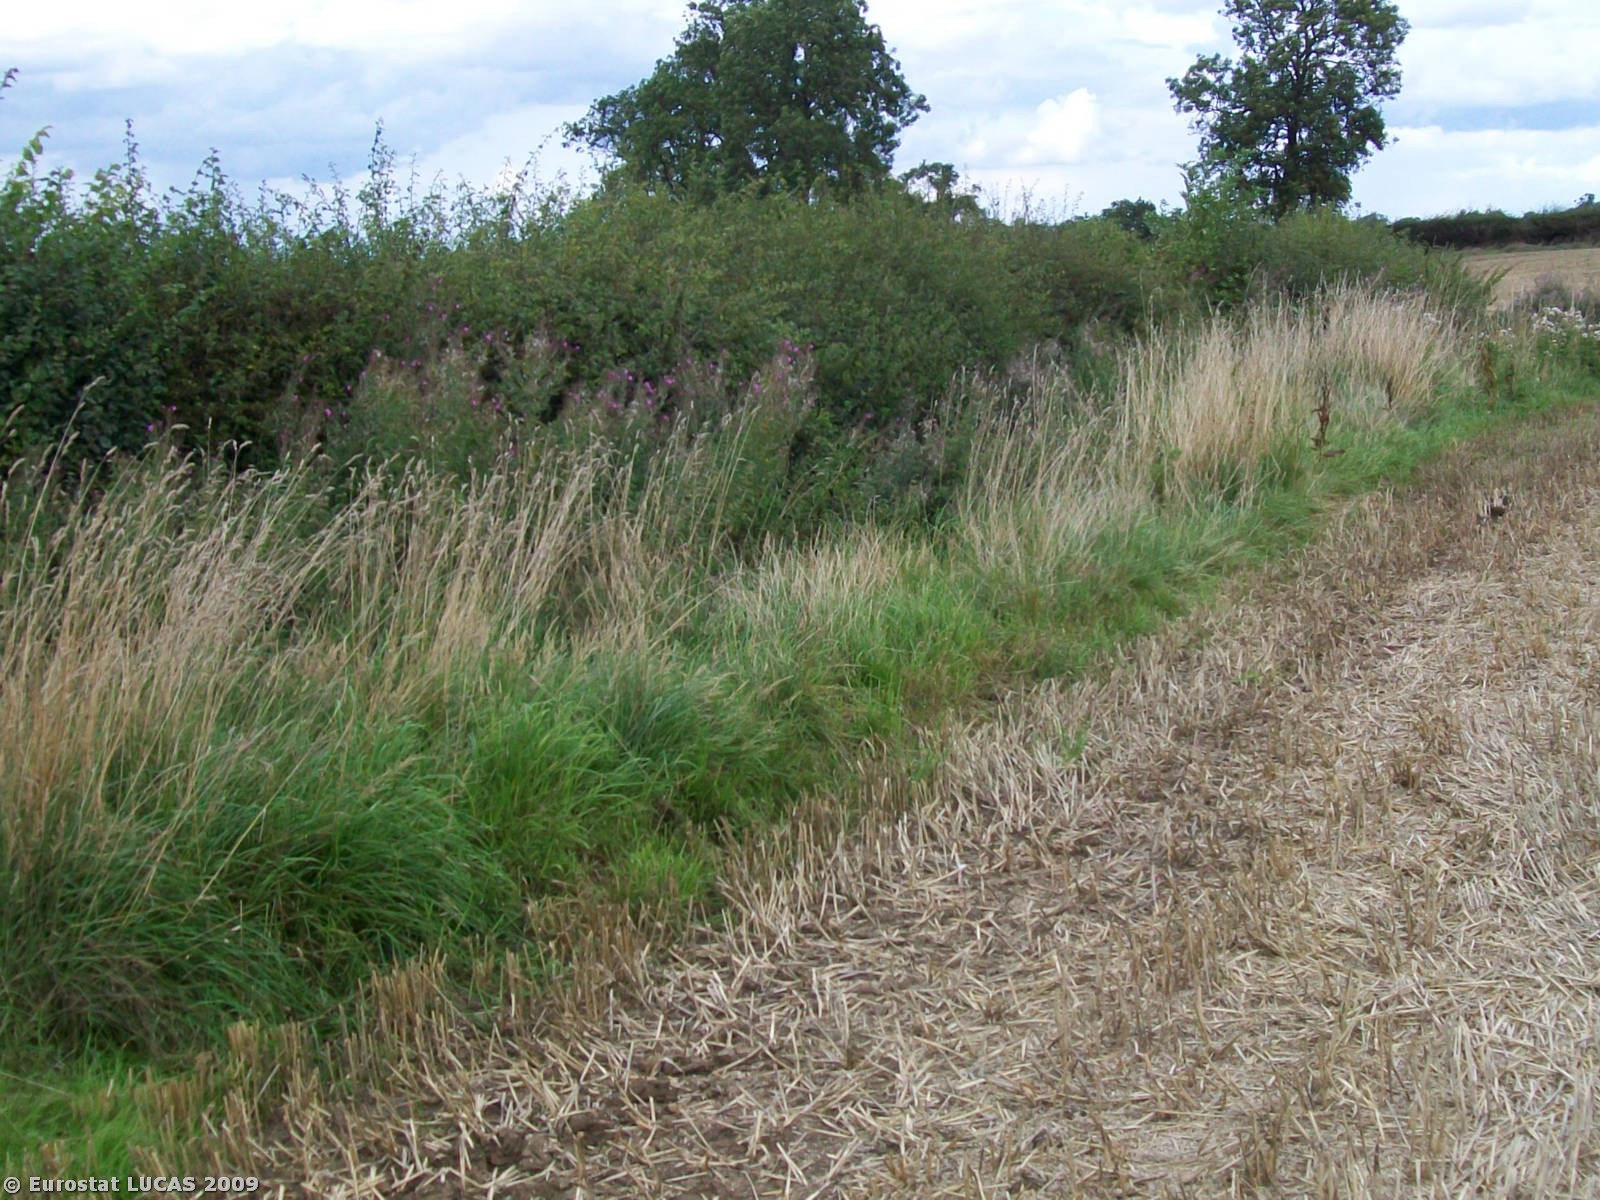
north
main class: Cropland
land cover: Common wheat
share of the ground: < 10 %
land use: Agriculture (excluding fallow land and kitchen gardens)
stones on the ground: < 10 %
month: August
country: GB
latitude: 52.5077
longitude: -1.1104
